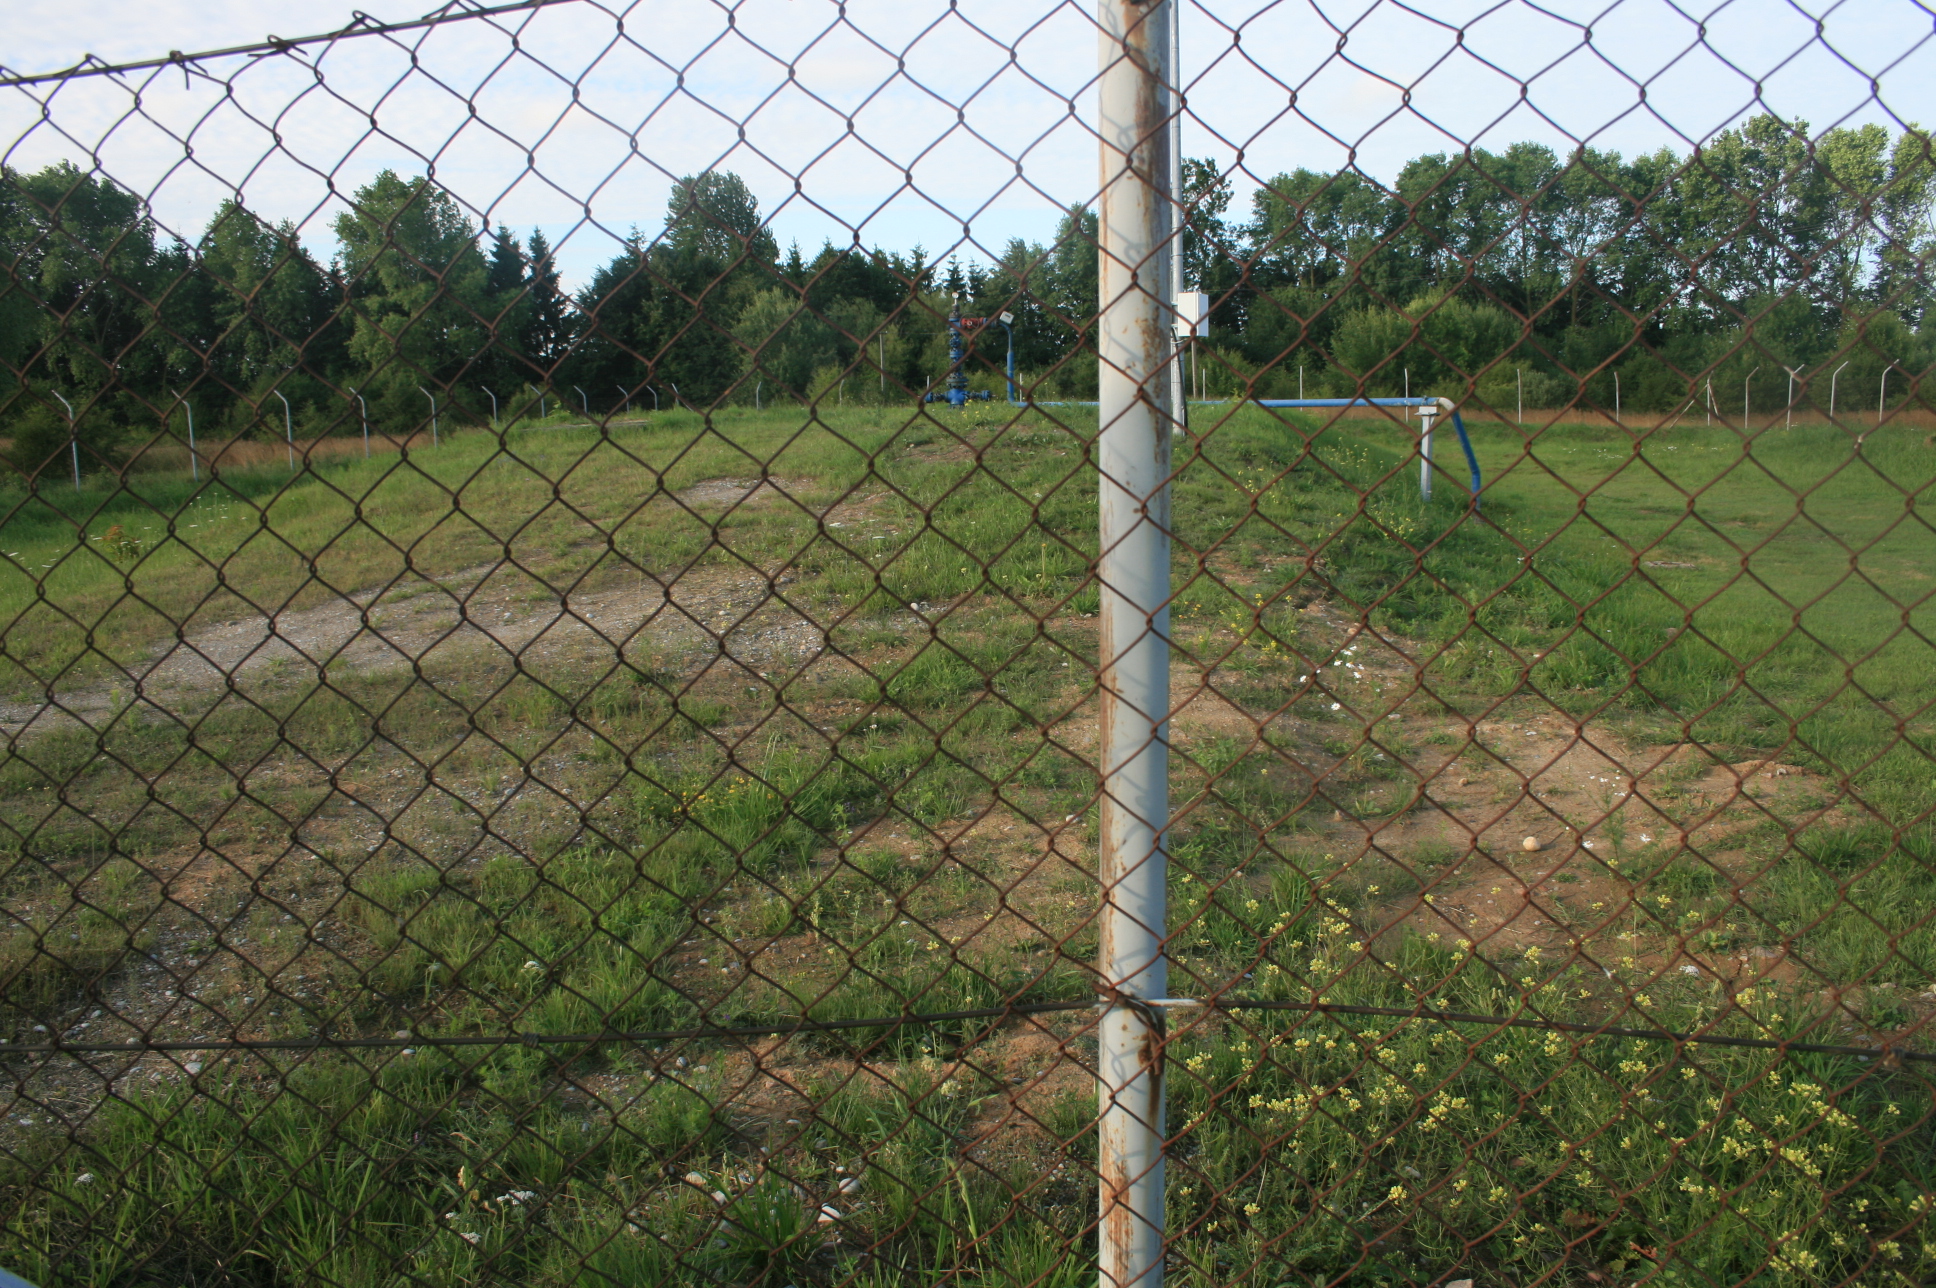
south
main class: Grassland
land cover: Grassland without tree/shrub cover
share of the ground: > 75 %
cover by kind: herbaceous plants 80 %, unconsolidated bare surface 20 %
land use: Transport via pipelines
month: July
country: LT
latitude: 55.8763
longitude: 21.2133
